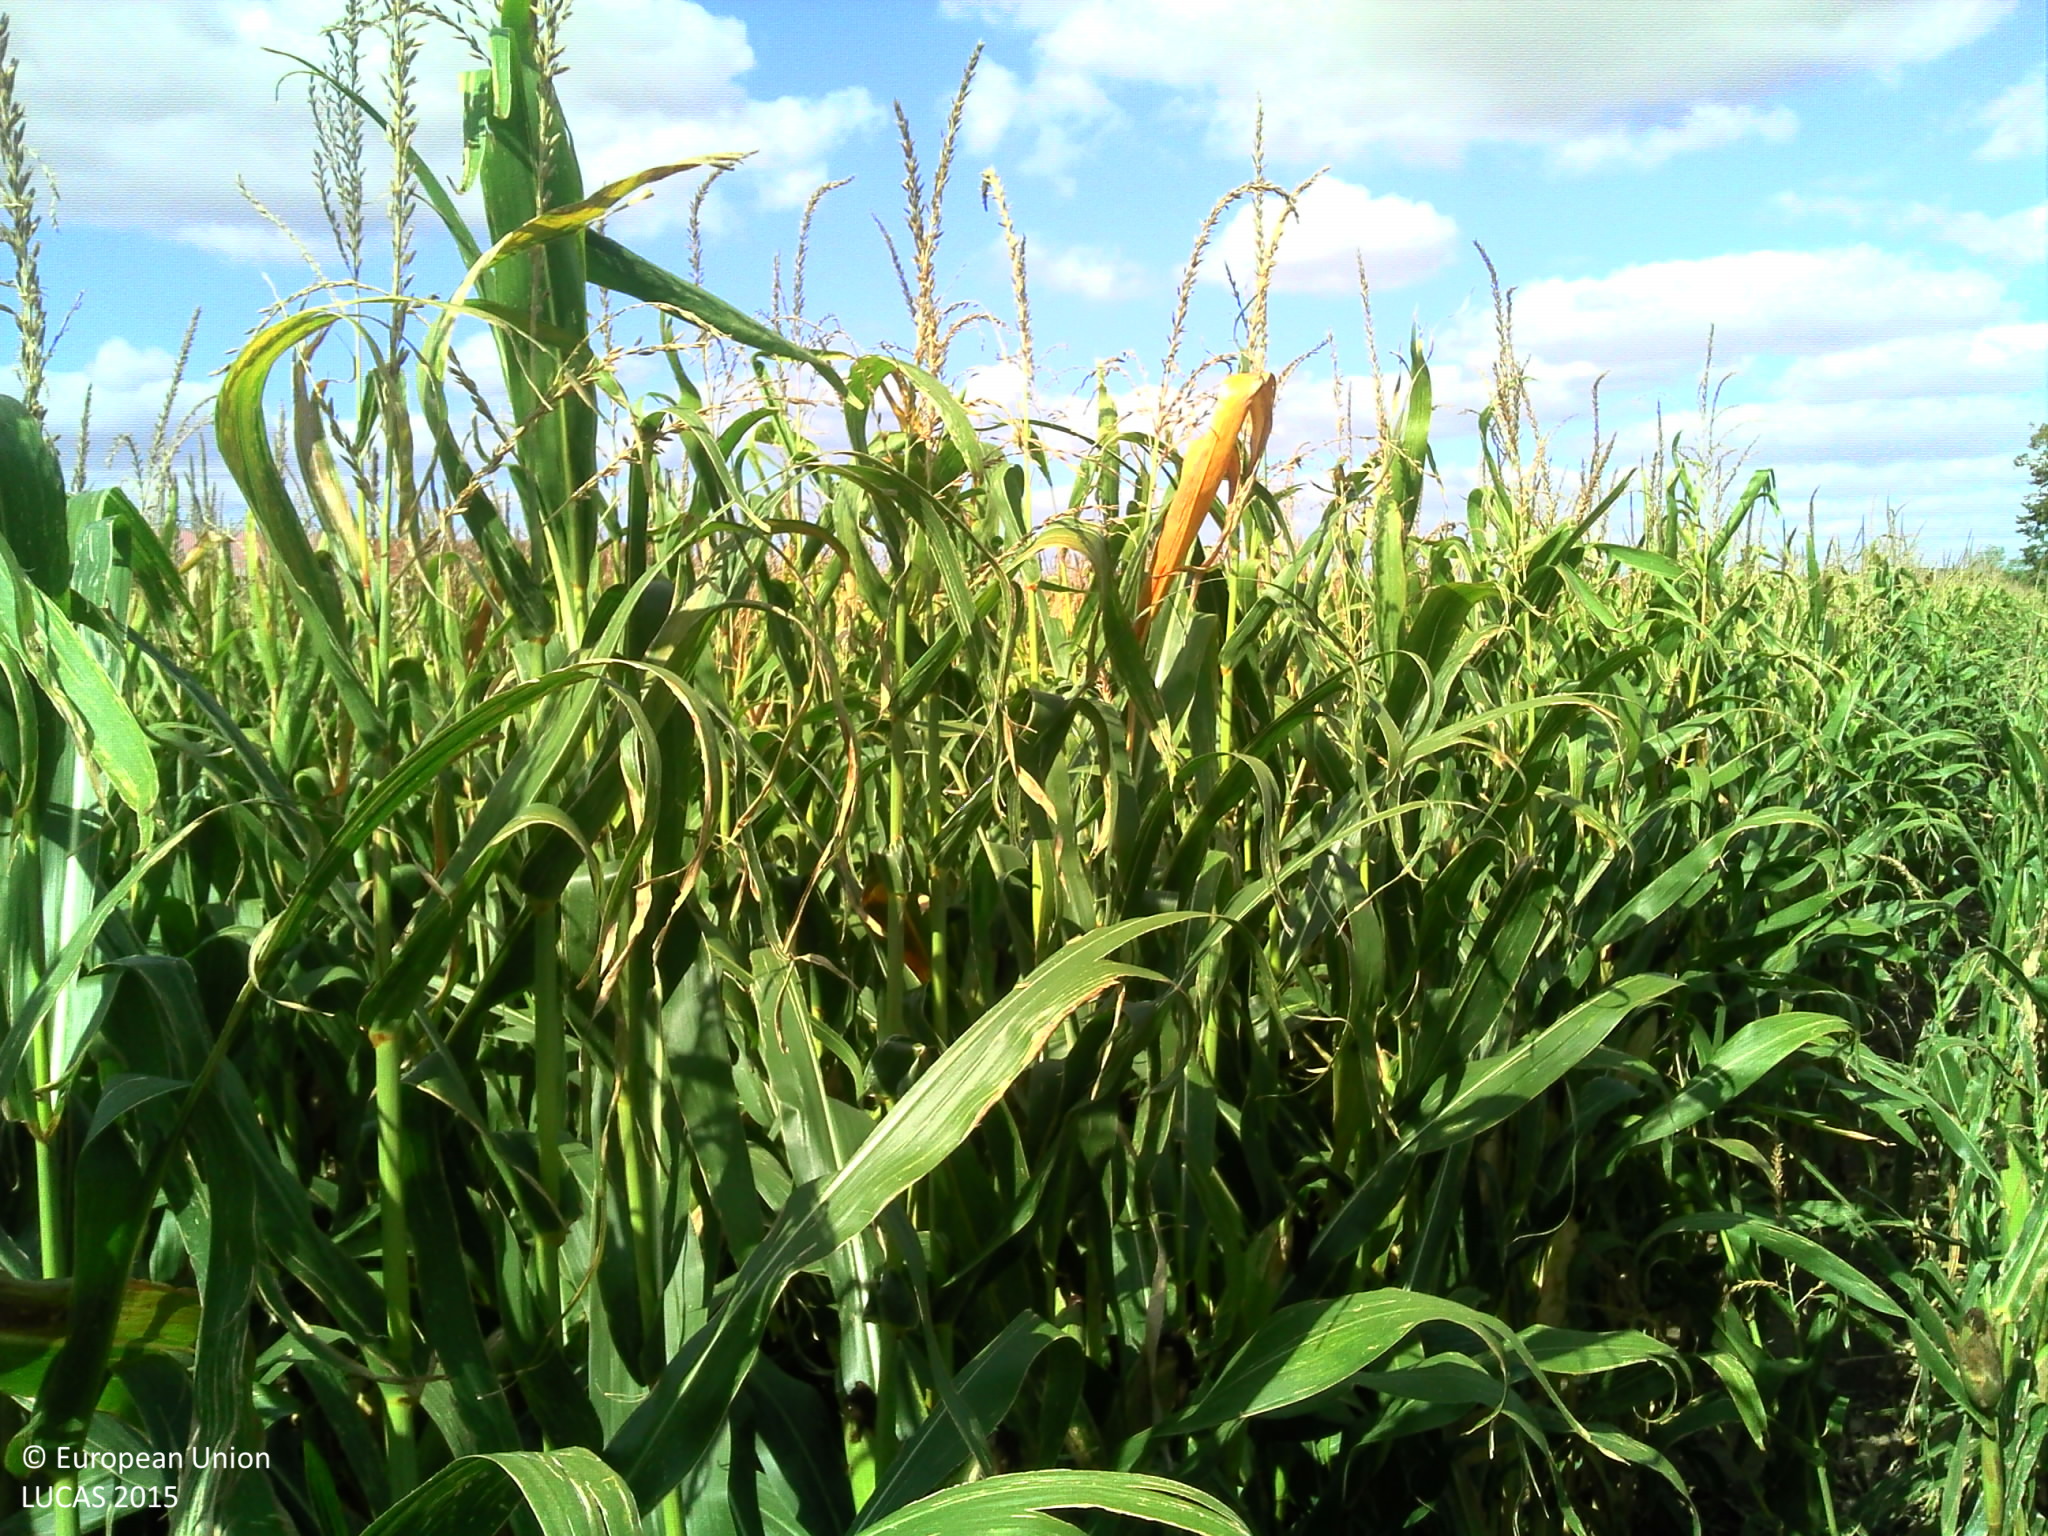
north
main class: Cropland
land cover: Maize
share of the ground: > 75 %
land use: Agriculture (excluding fallow land and kitchen gardens)
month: September
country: FR
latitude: 46.9272
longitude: 1.6230
